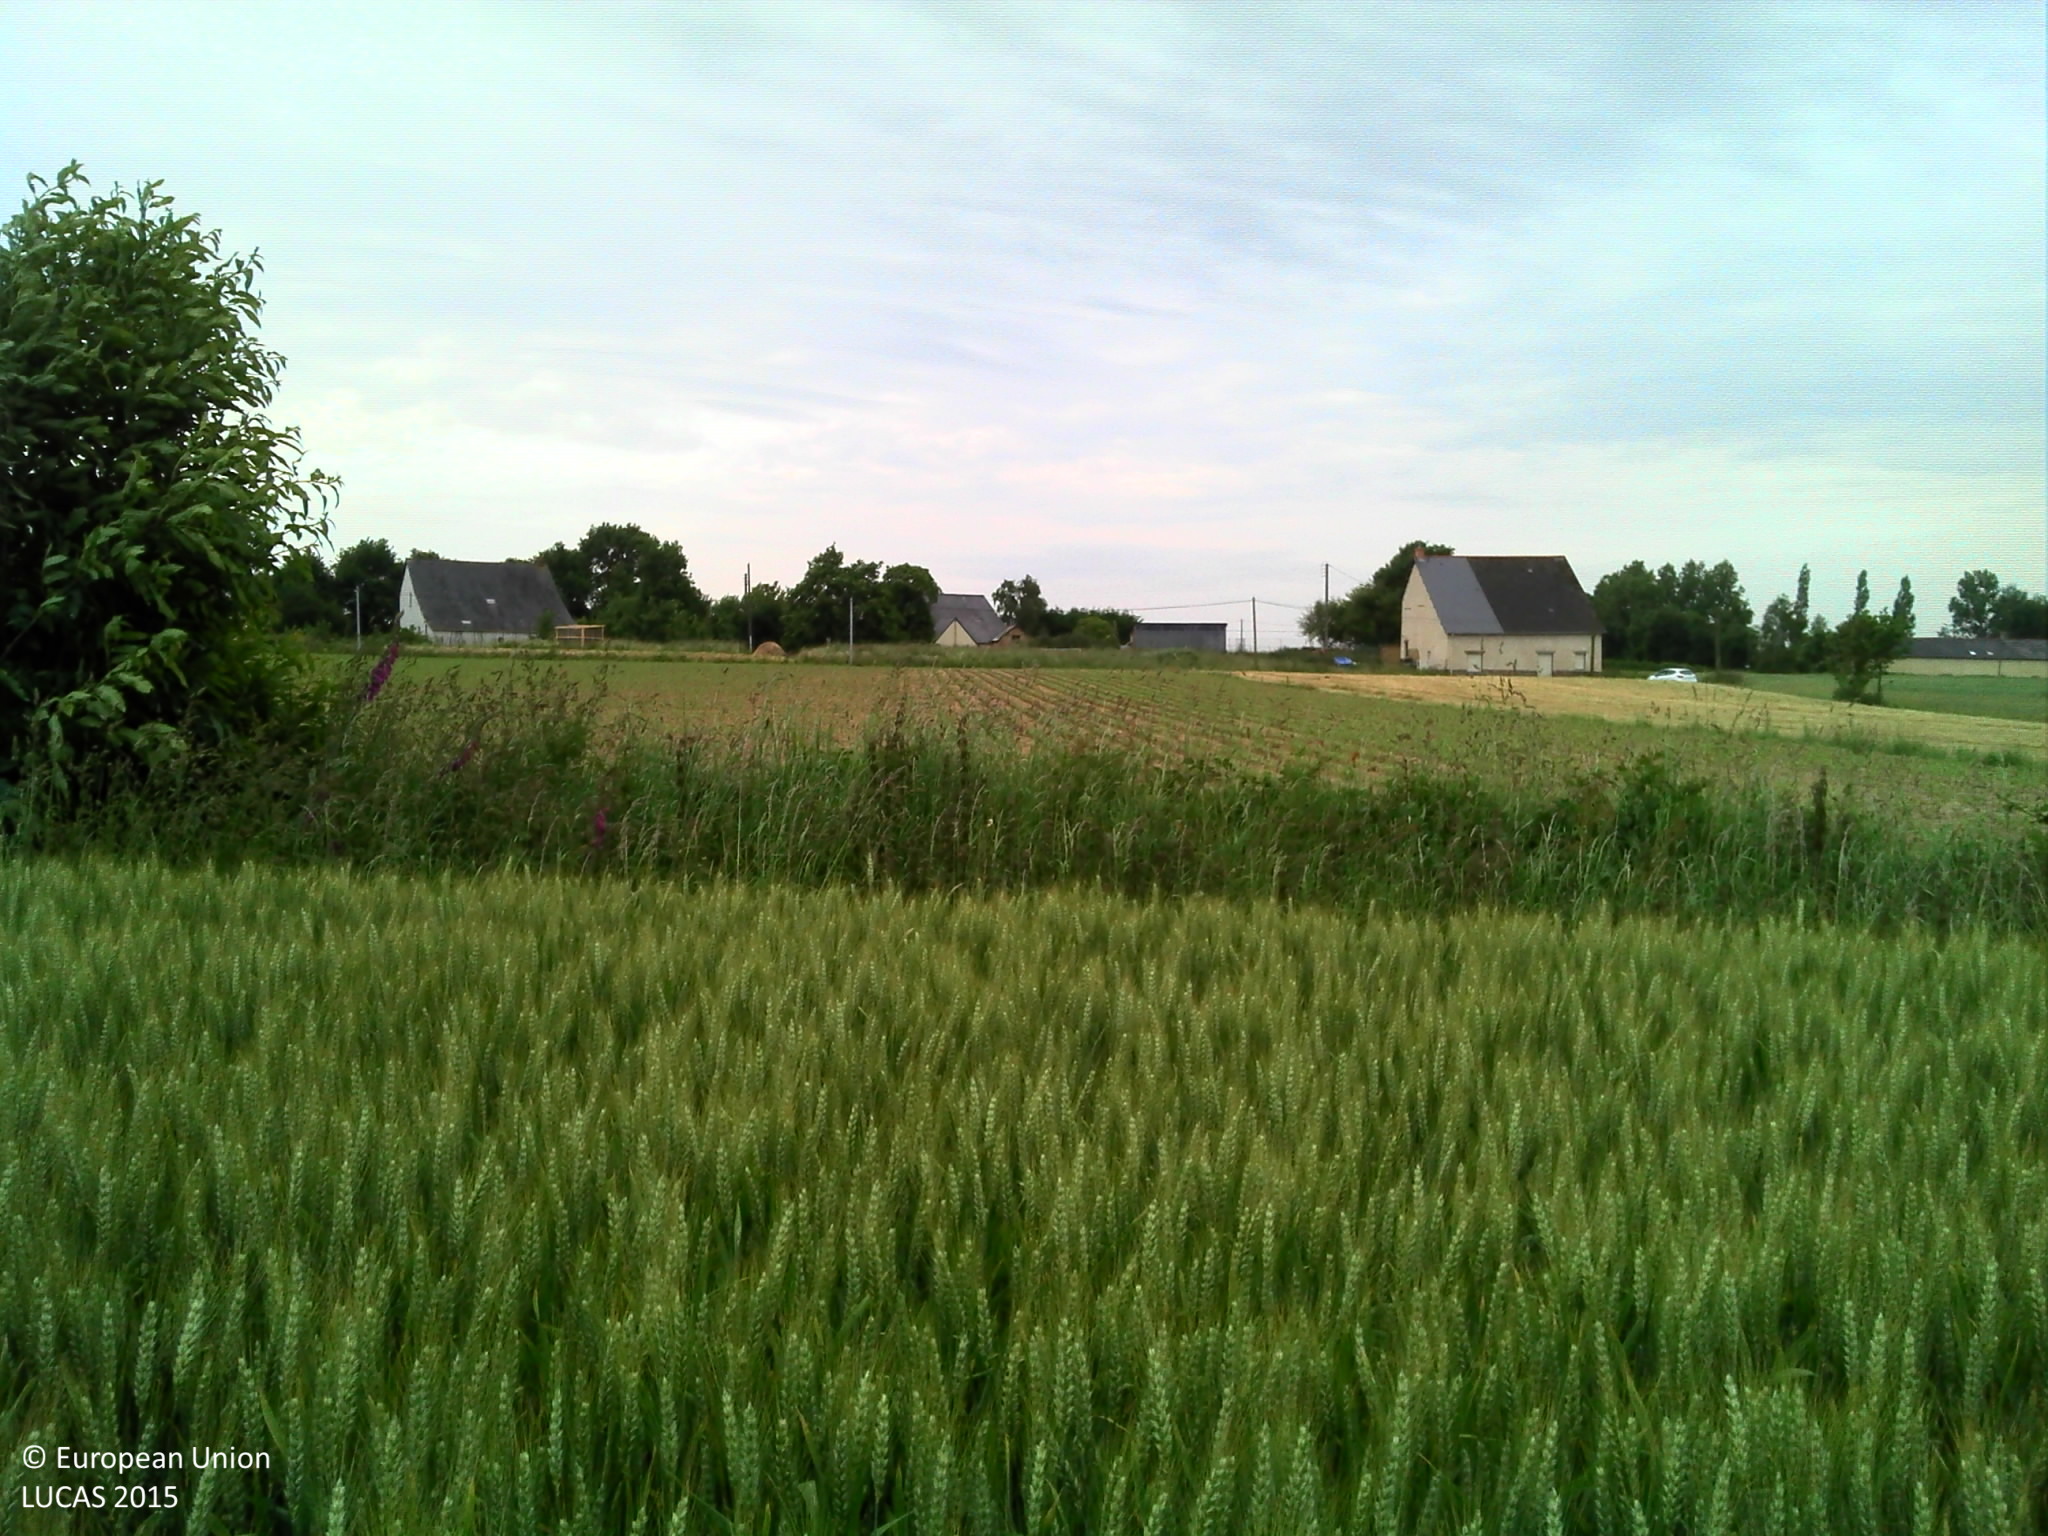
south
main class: Cropland
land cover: Common wheat
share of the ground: > 75 %
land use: Agriculture (excluding fallow land and kitchen gardens)
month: June
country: FR
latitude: 48.1914
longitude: -1.9303
